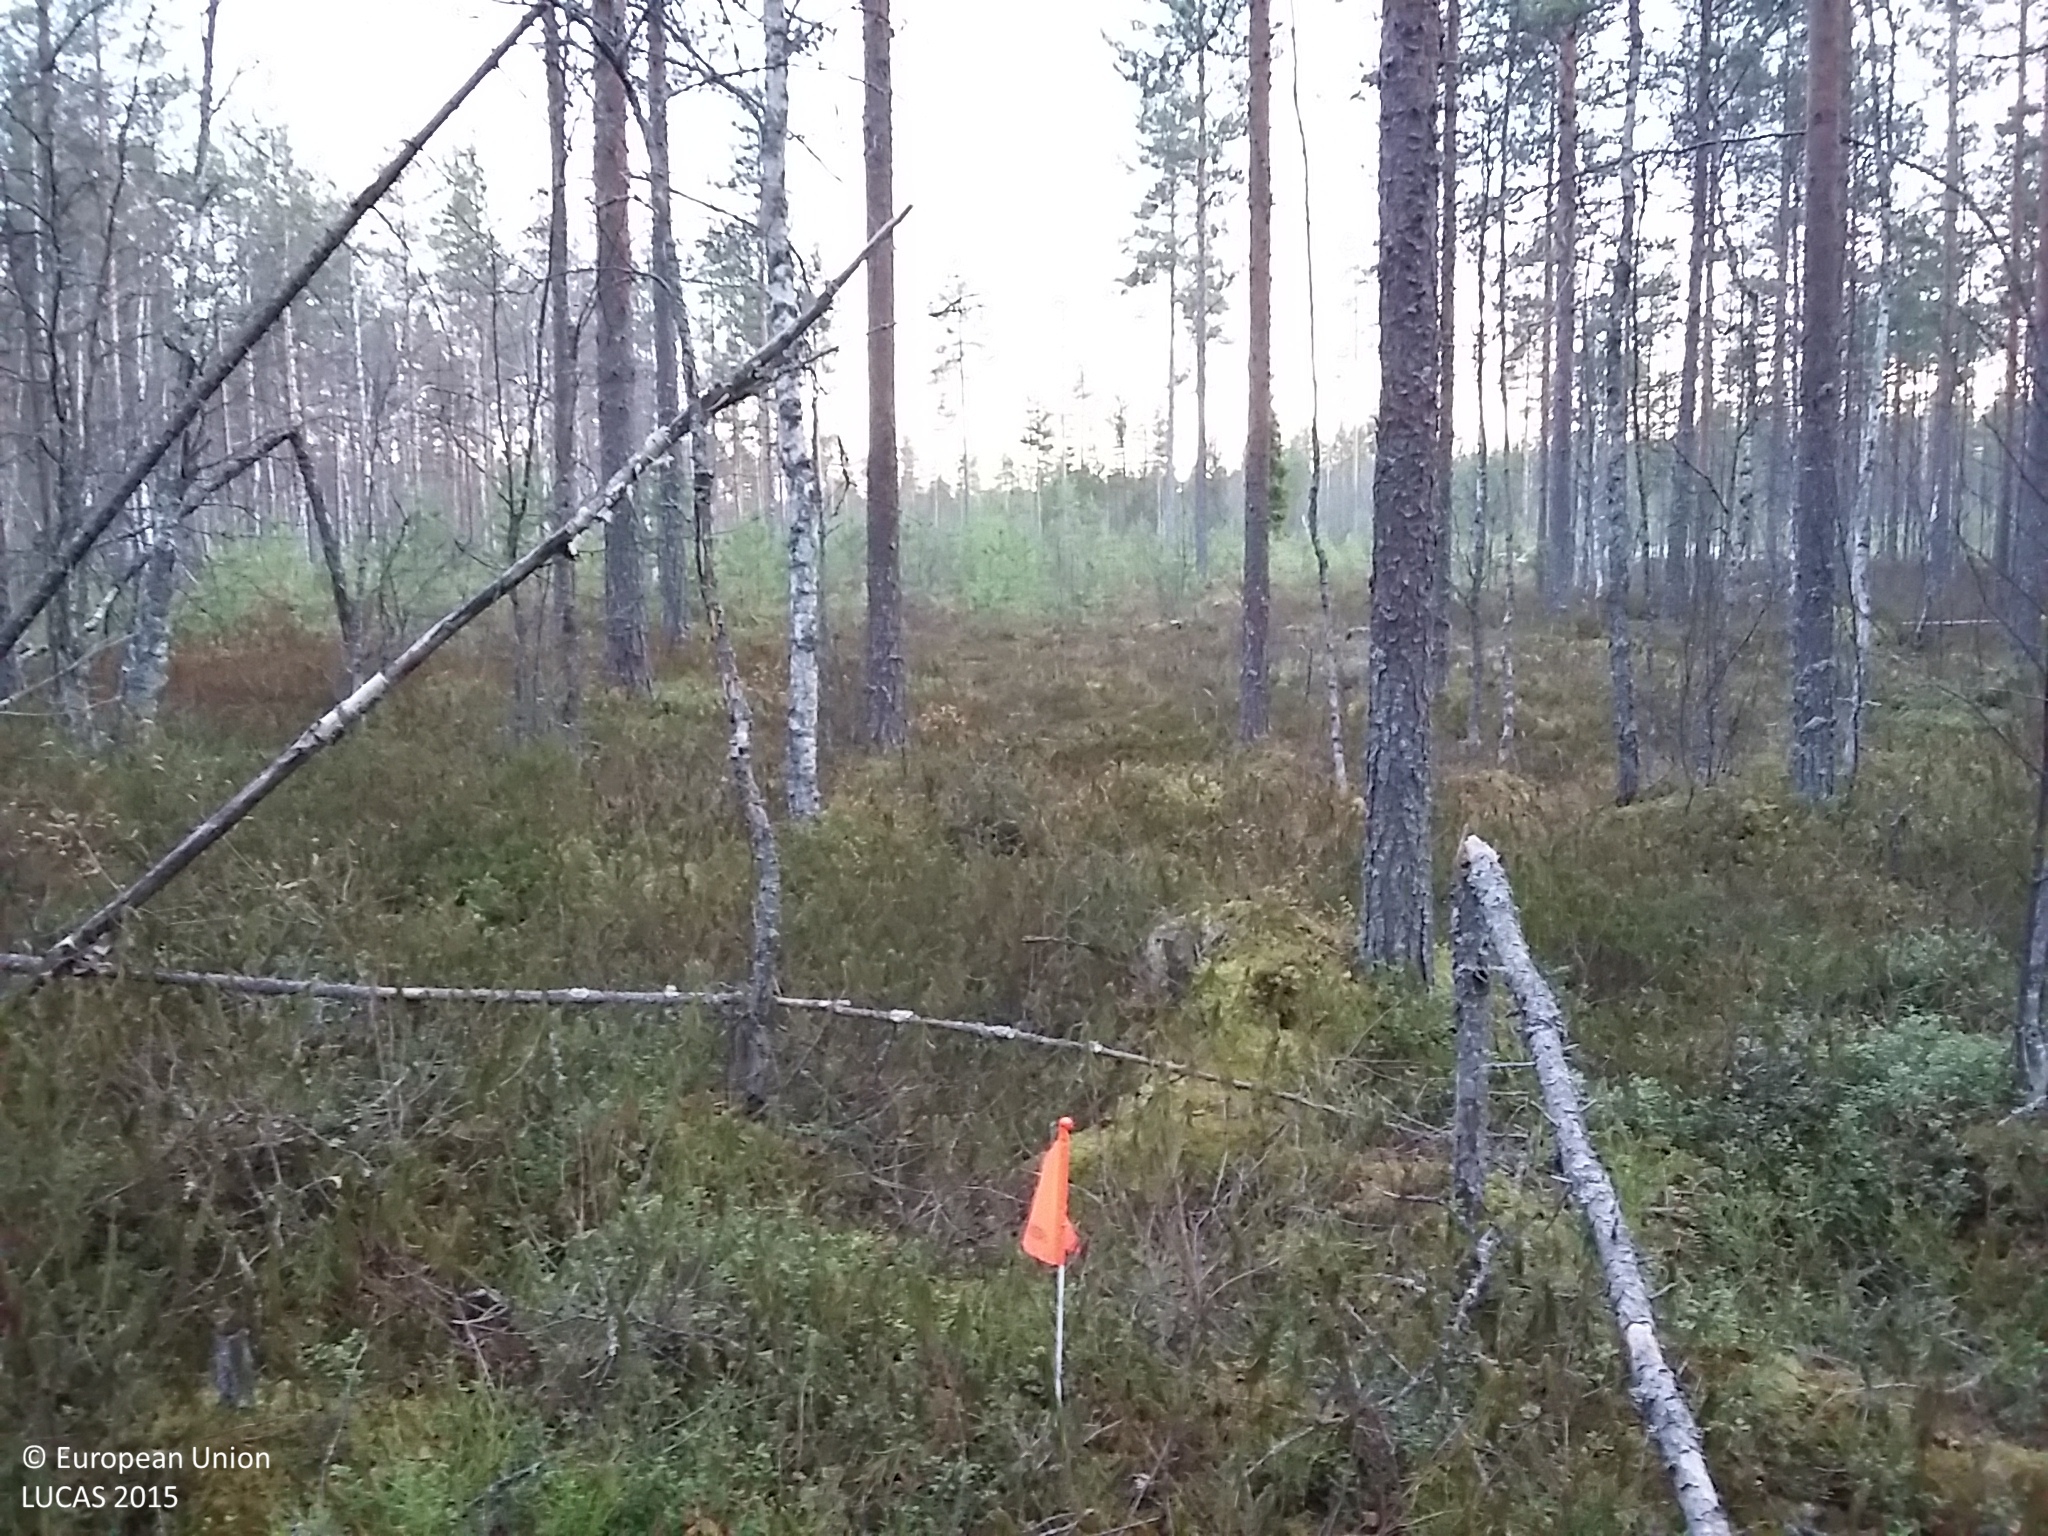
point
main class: Woodland
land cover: Pine dominated coniferous woodland
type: boreal forest
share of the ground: > 75 %
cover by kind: coniferous forest trees 75 %, shrubs 10 %, lichens and mosses 10 %, herbaceous plants 5 %
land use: Forestry
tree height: > 5 m
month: October
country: FI
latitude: 64.0647
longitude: 25.0241
